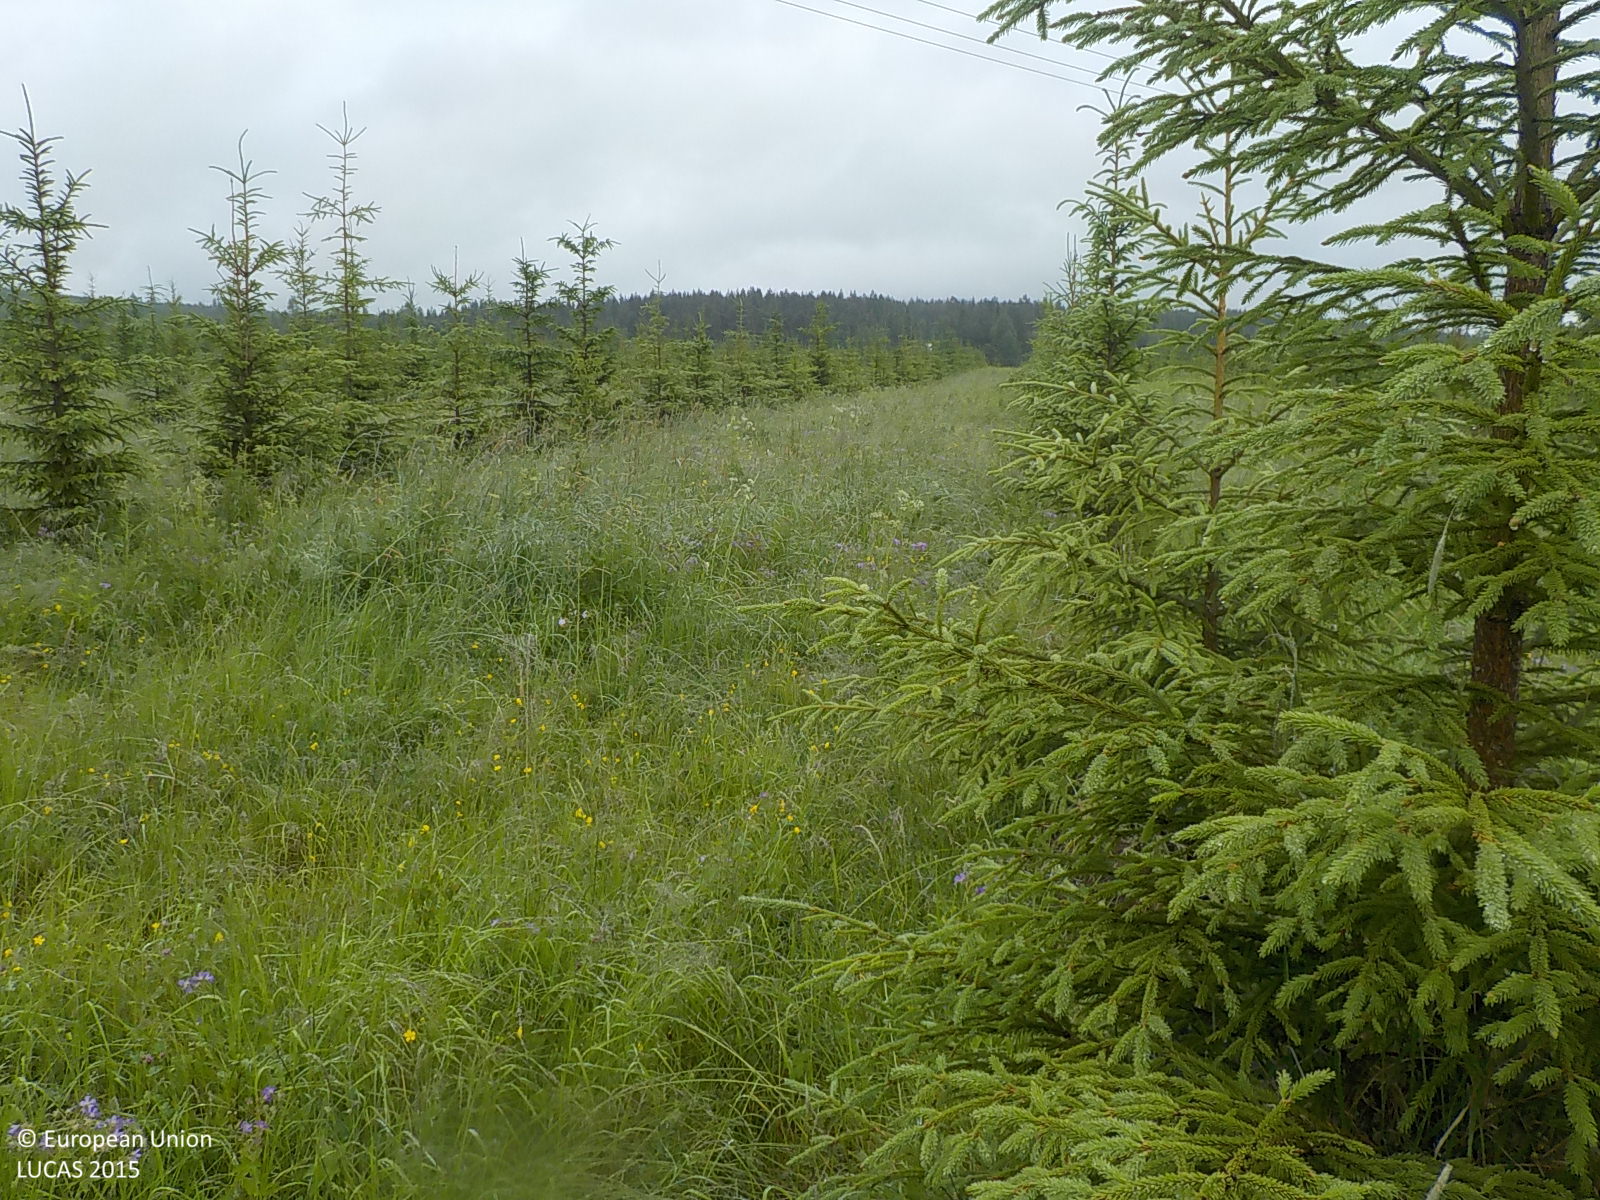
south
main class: Woodland
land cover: Spruce dominated coniferous woodland
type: boreal forest
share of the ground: 50 - 75 %
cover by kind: coniferous forest trees 50 %, herbaceous plants 50 %
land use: Forestry
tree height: < 5 m
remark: Nursery
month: July
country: SE
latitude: 63.1729
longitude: 17.0264
